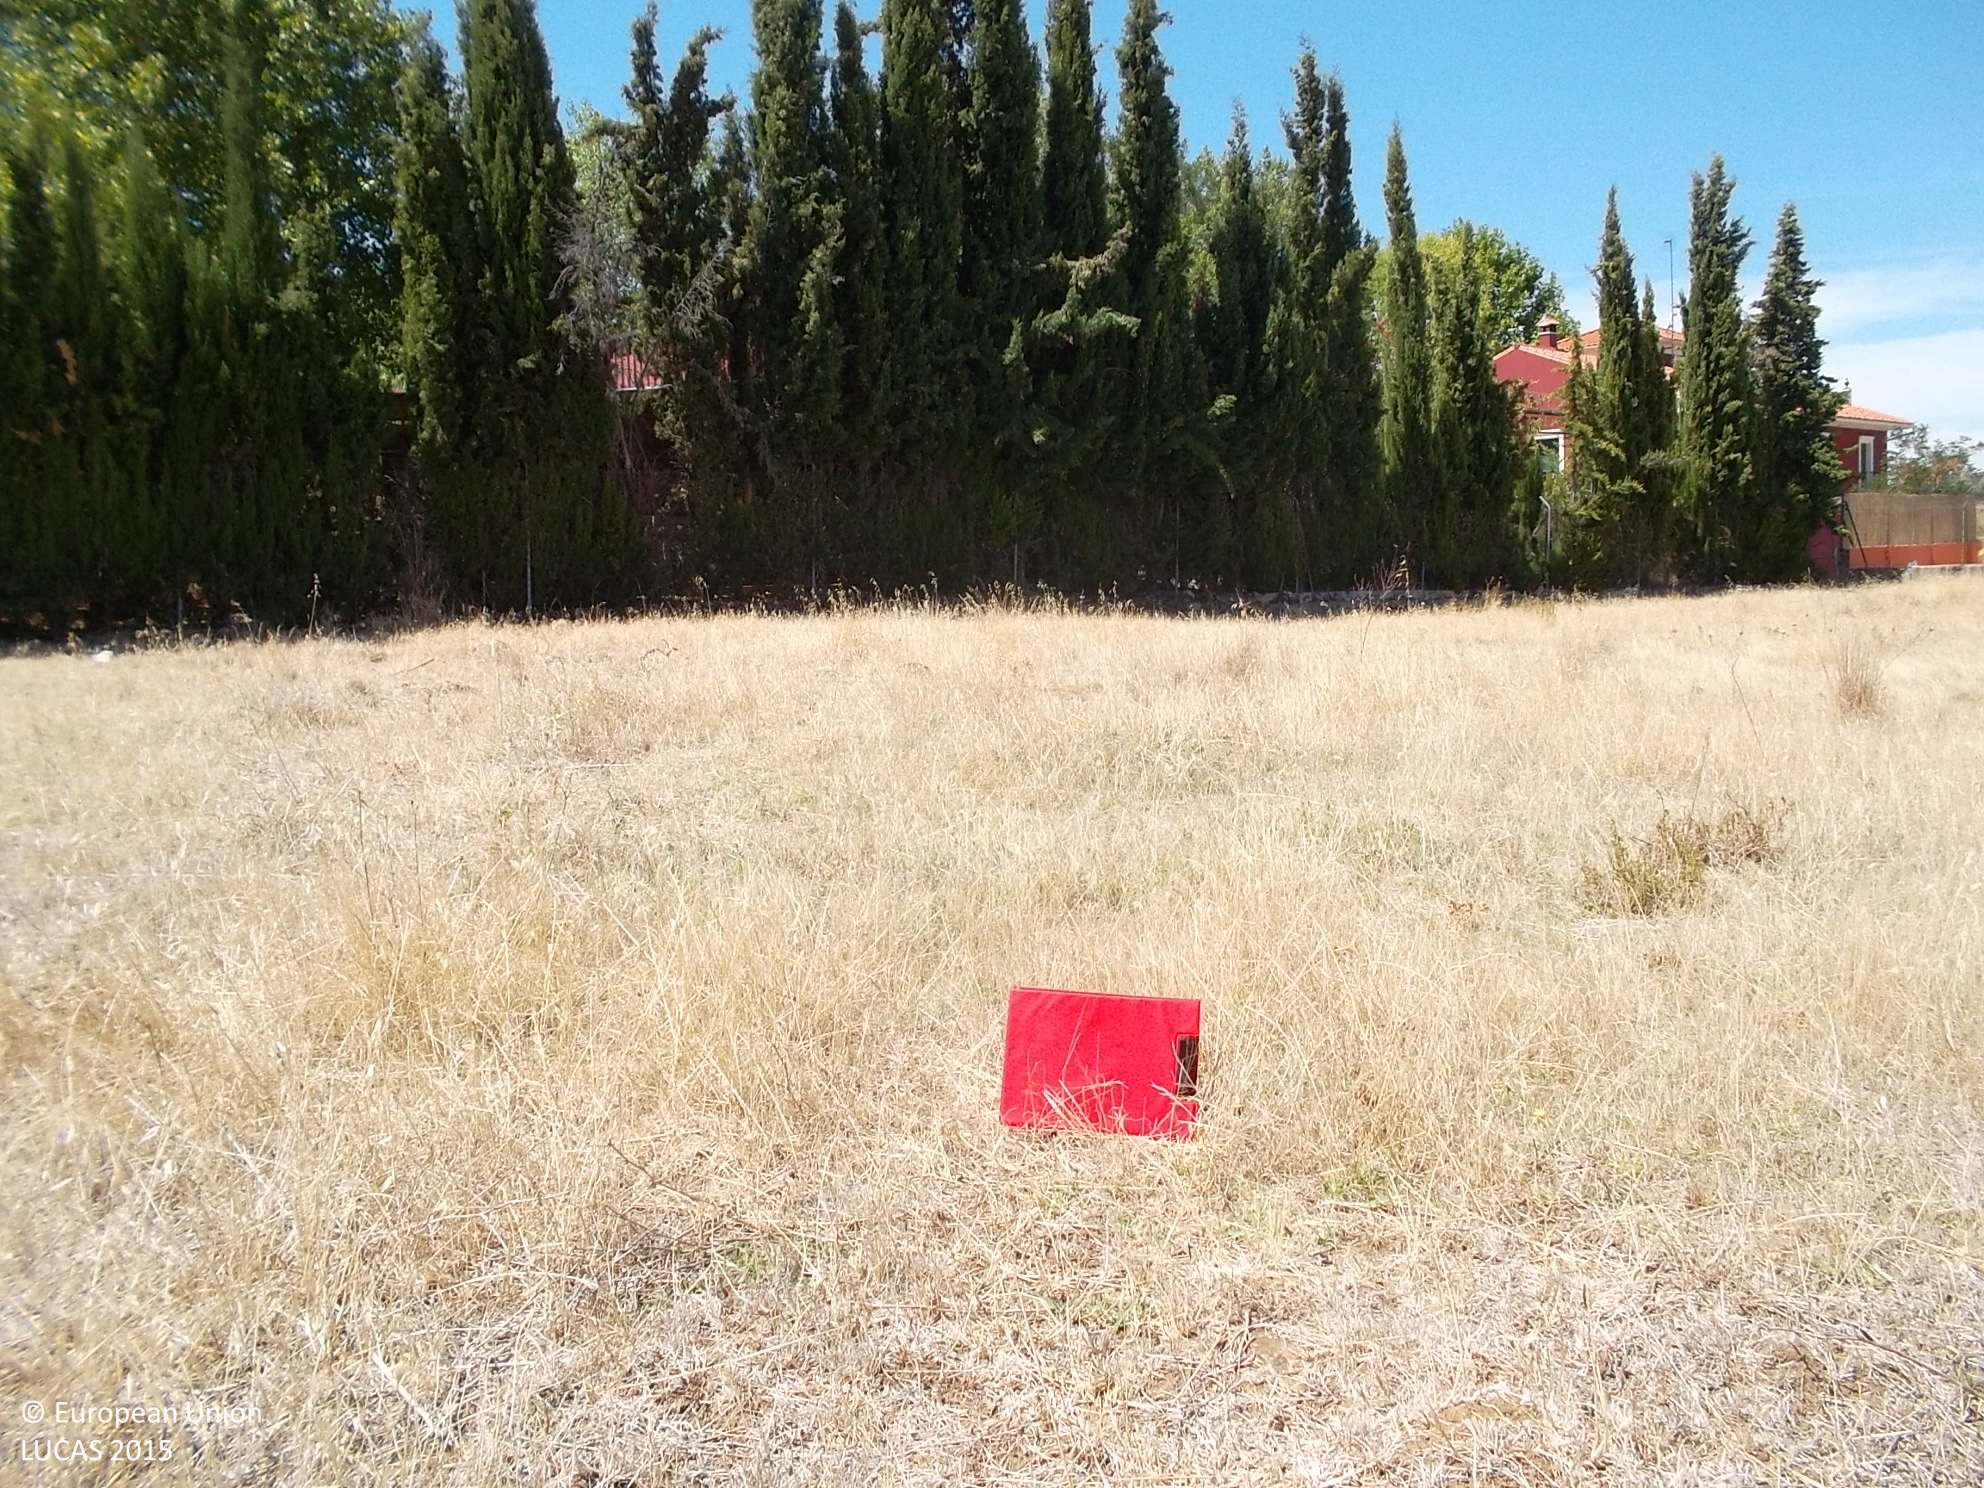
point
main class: Grassland
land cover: Spontaneously vegetated surfaces
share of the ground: > 75 %
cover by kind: herbaceous plants 100 %
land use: Fallow land
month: August
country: ES
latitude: 38.1681
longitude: -6.6579
